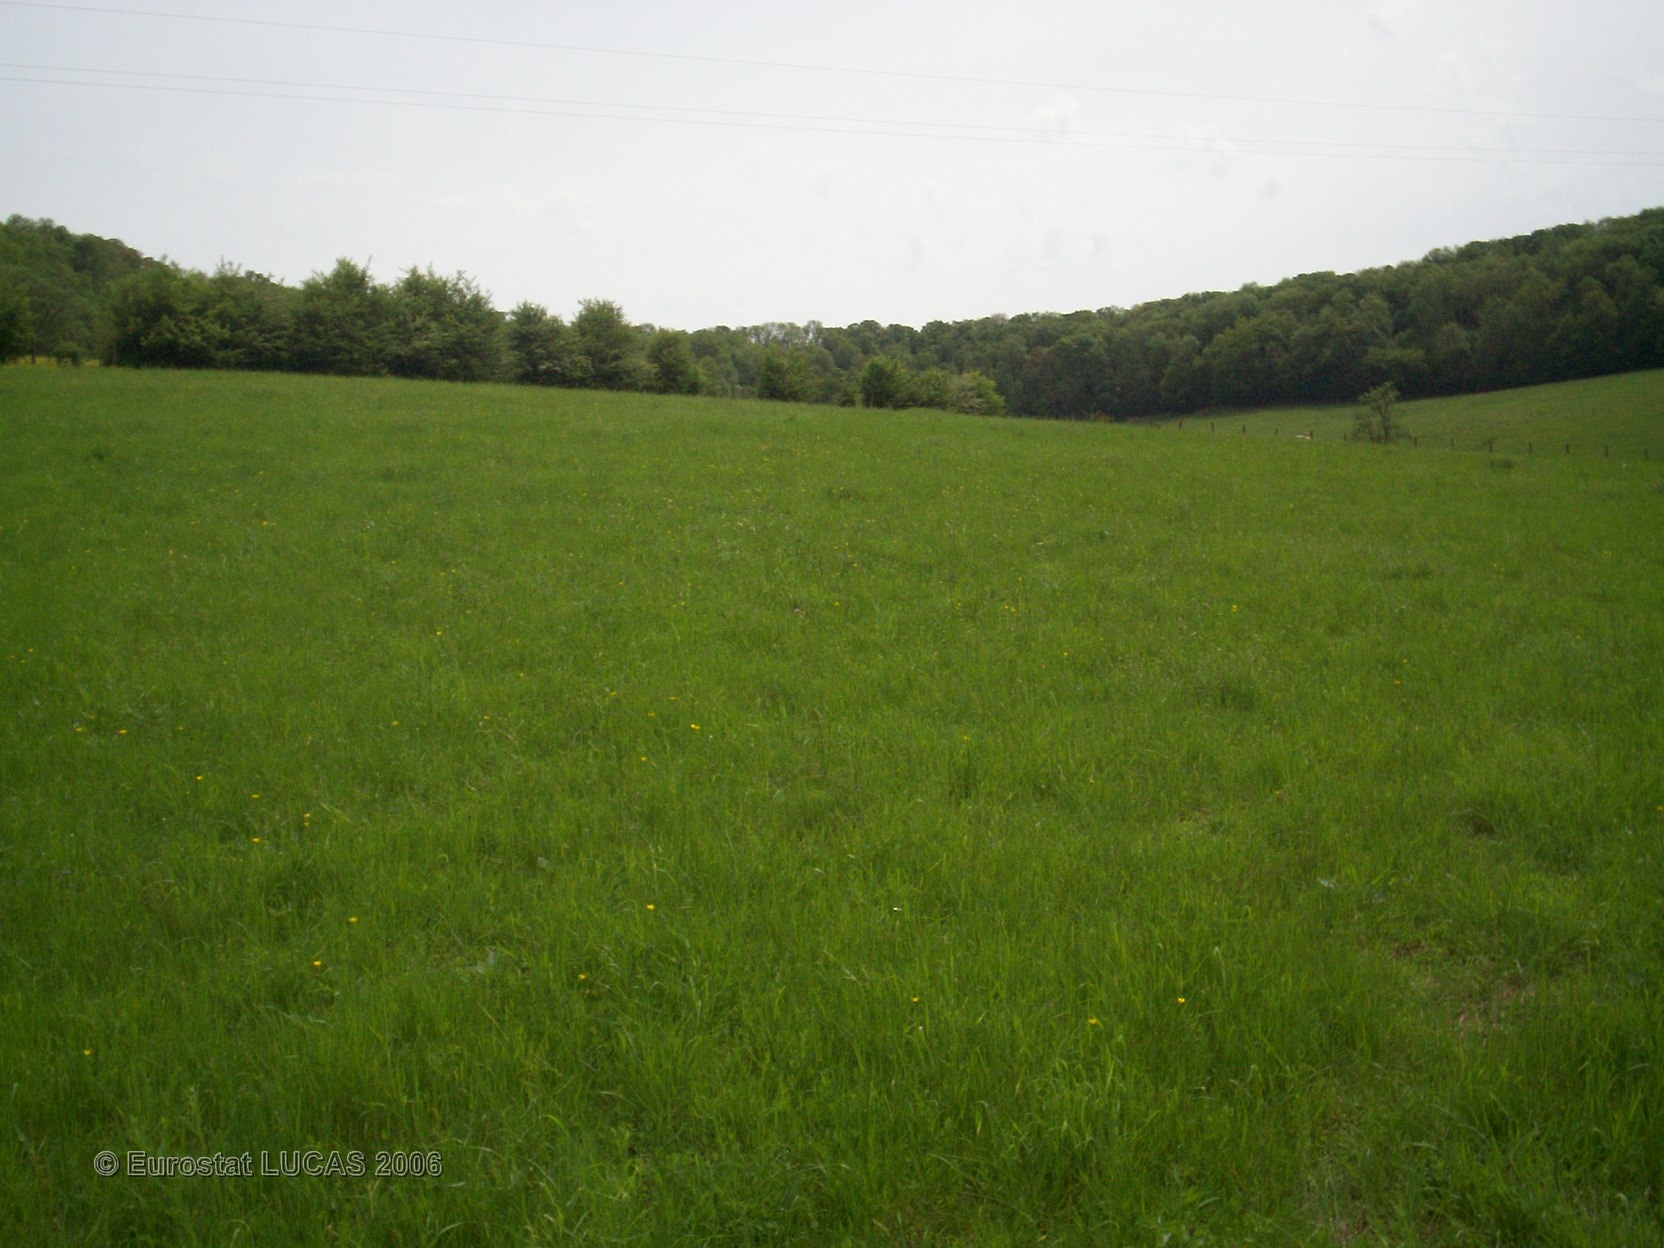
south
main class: Grassland
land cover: Grassland without tree/shrub cover
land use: Agriculture (excluding fallow land and kitchen gardens)
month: May
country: FR
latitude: 47.2997
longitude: 4.6436
